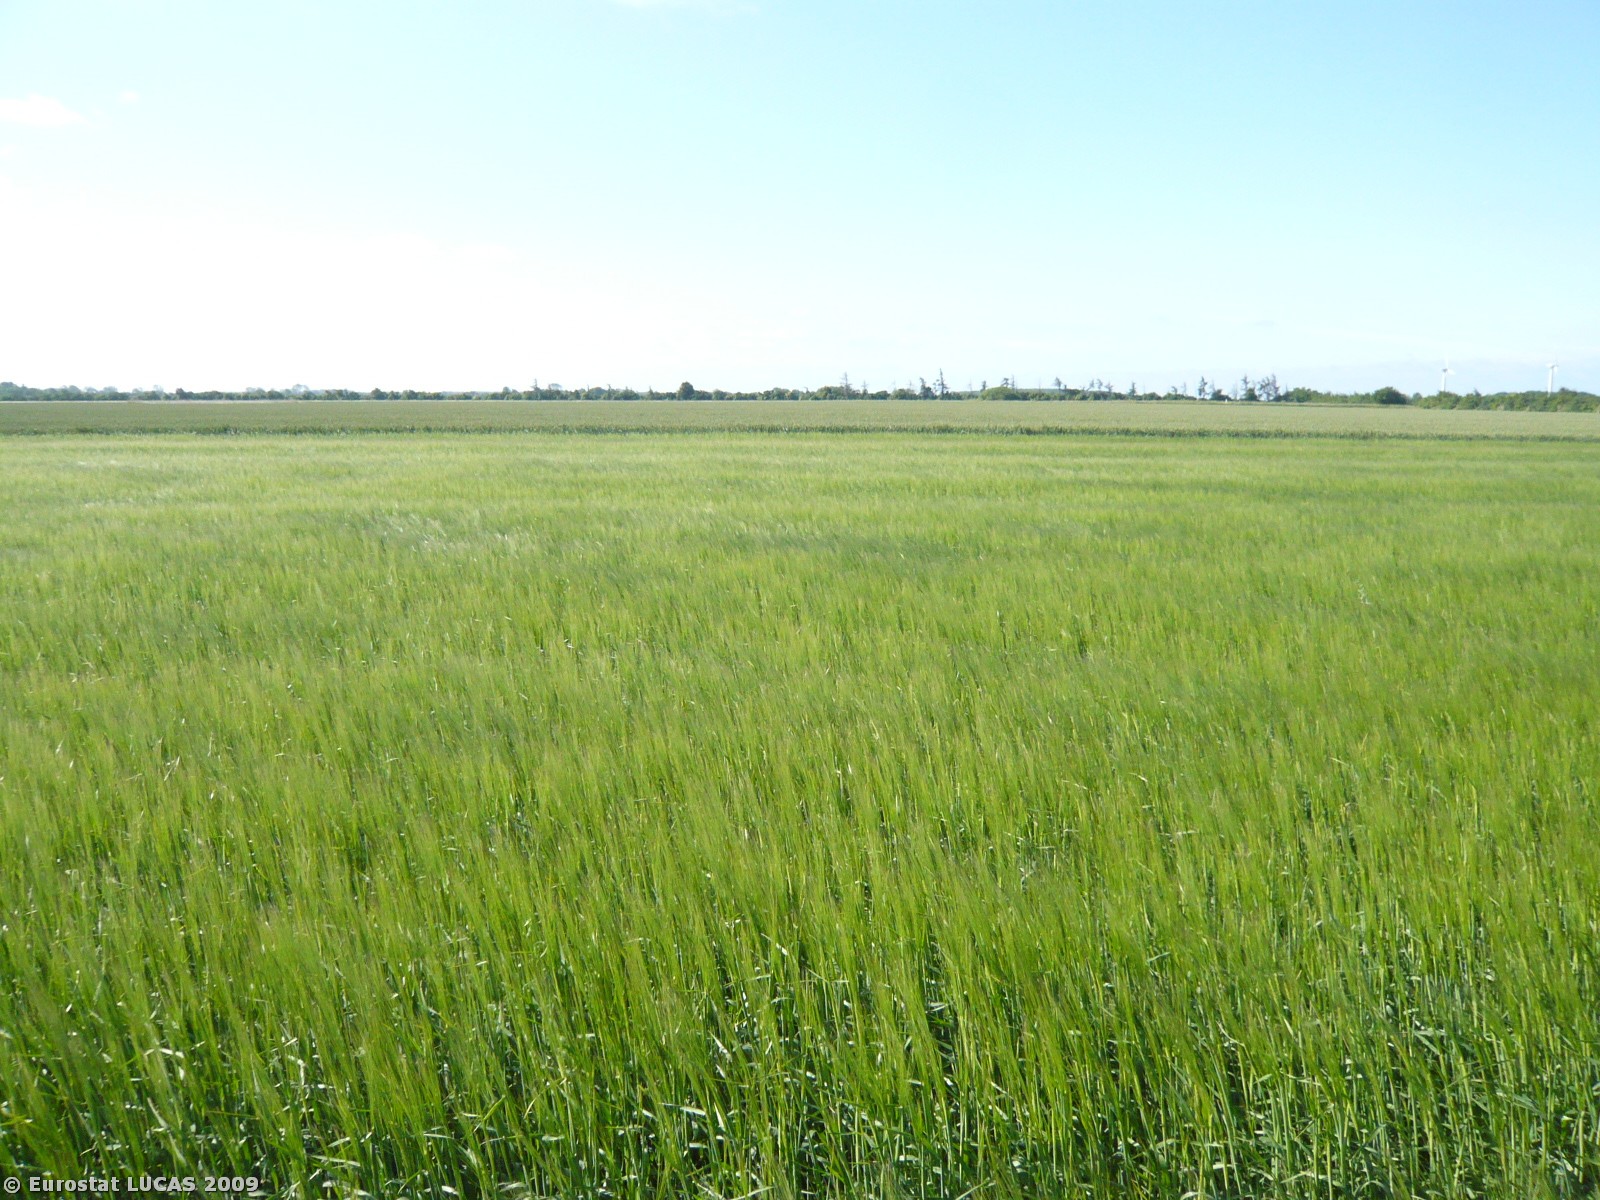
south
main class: Cropland
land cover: Barley
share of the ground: > 75 %
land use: Agriculture (excluding fallow land and kitchen gardens)
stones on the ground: < 10 %
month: June
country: DK
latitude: 54.7991
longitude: 11.0725
